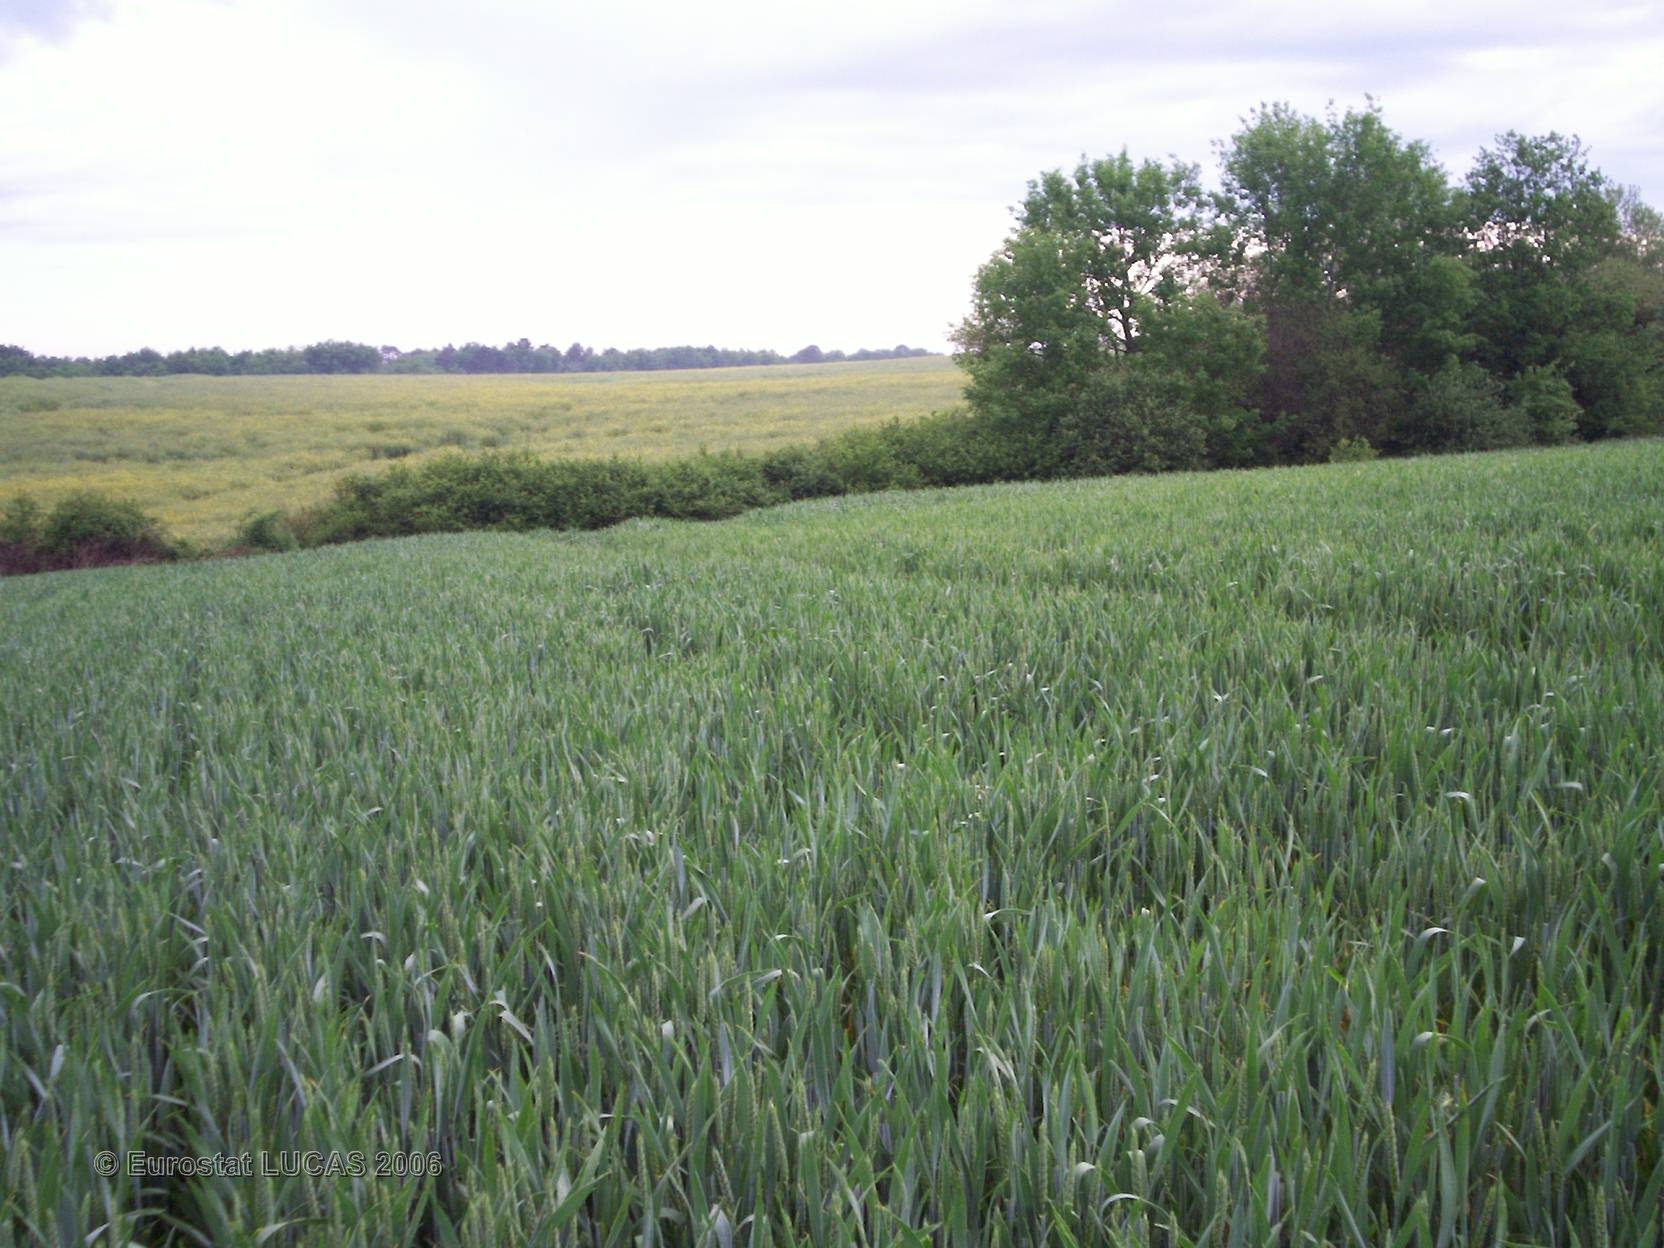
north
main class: Cropland
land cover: Common wheat
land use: Agriculture (excluding fallow land and kitchen gardens)
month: May
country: FR
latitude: 46.8410
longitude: 1.0031
